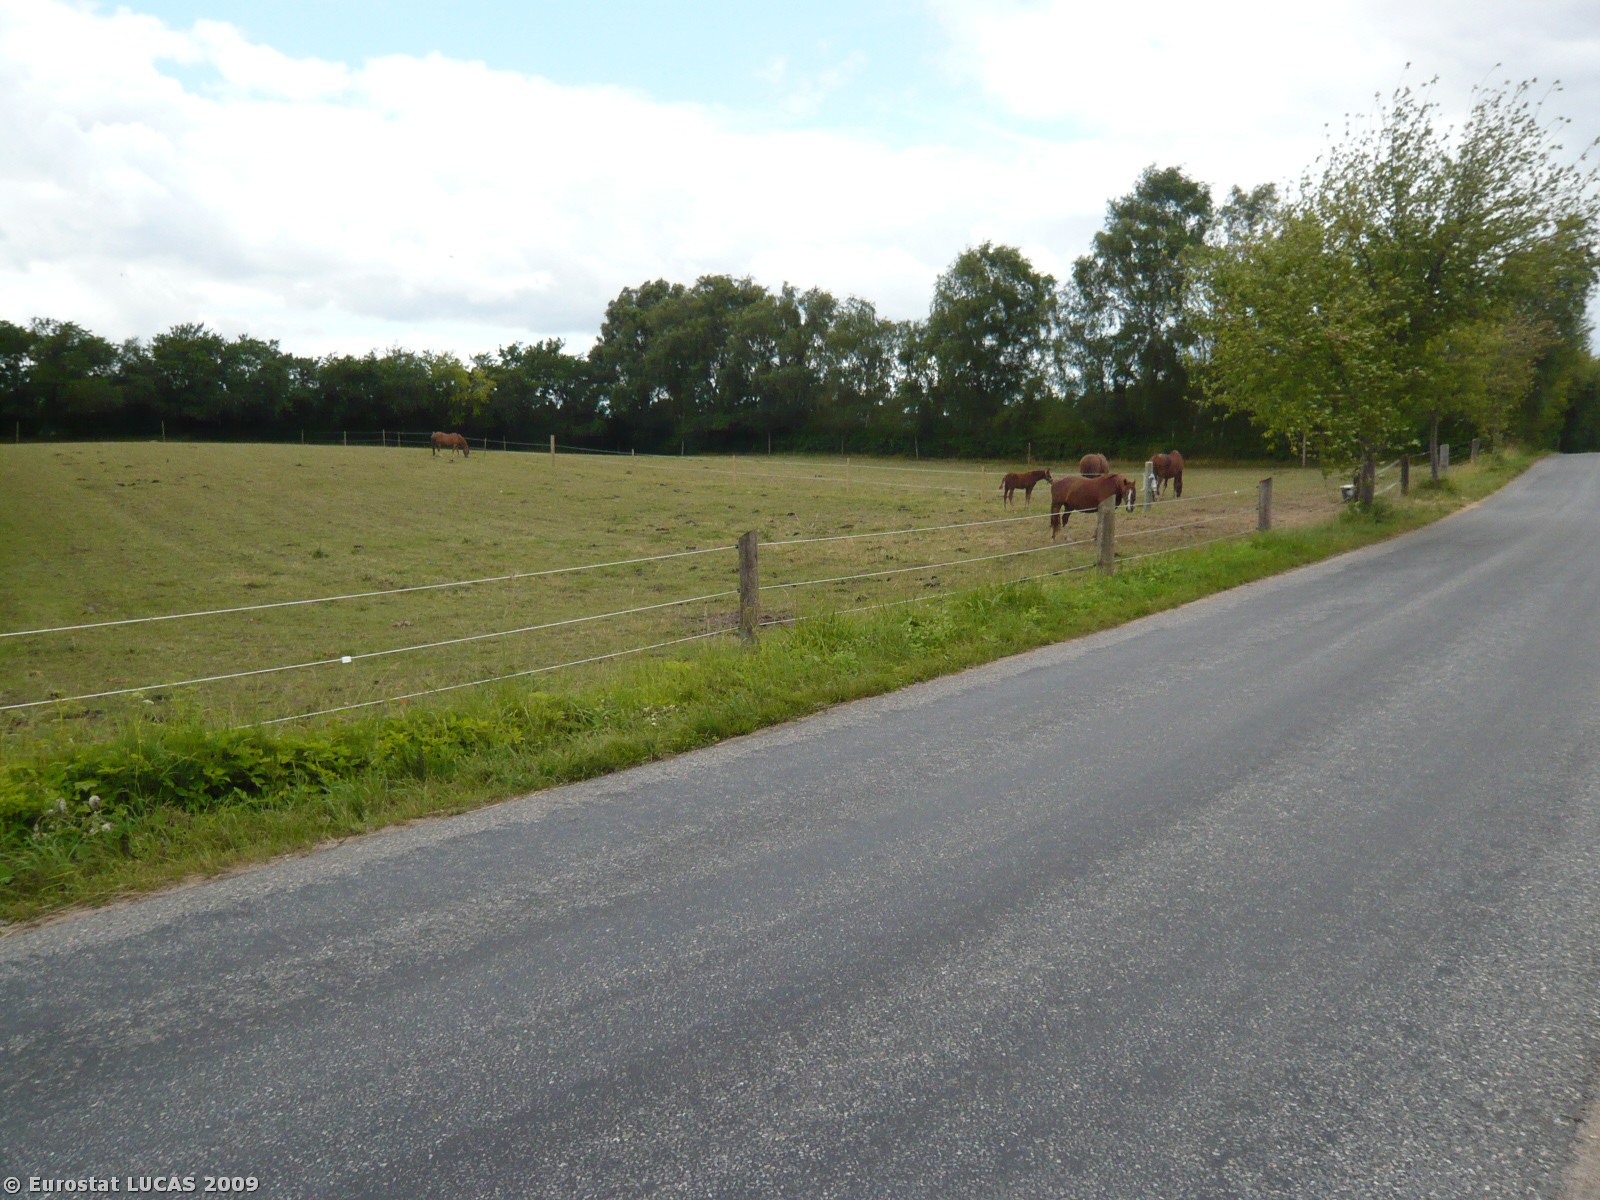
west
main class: Grassland
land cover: Grassland without tree/shrub cover
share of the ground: > 75 %
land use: Agriculture (excluding fallow land and kitchen gardens)
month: July
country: DK
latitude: 55.4763
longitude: 11.6282
